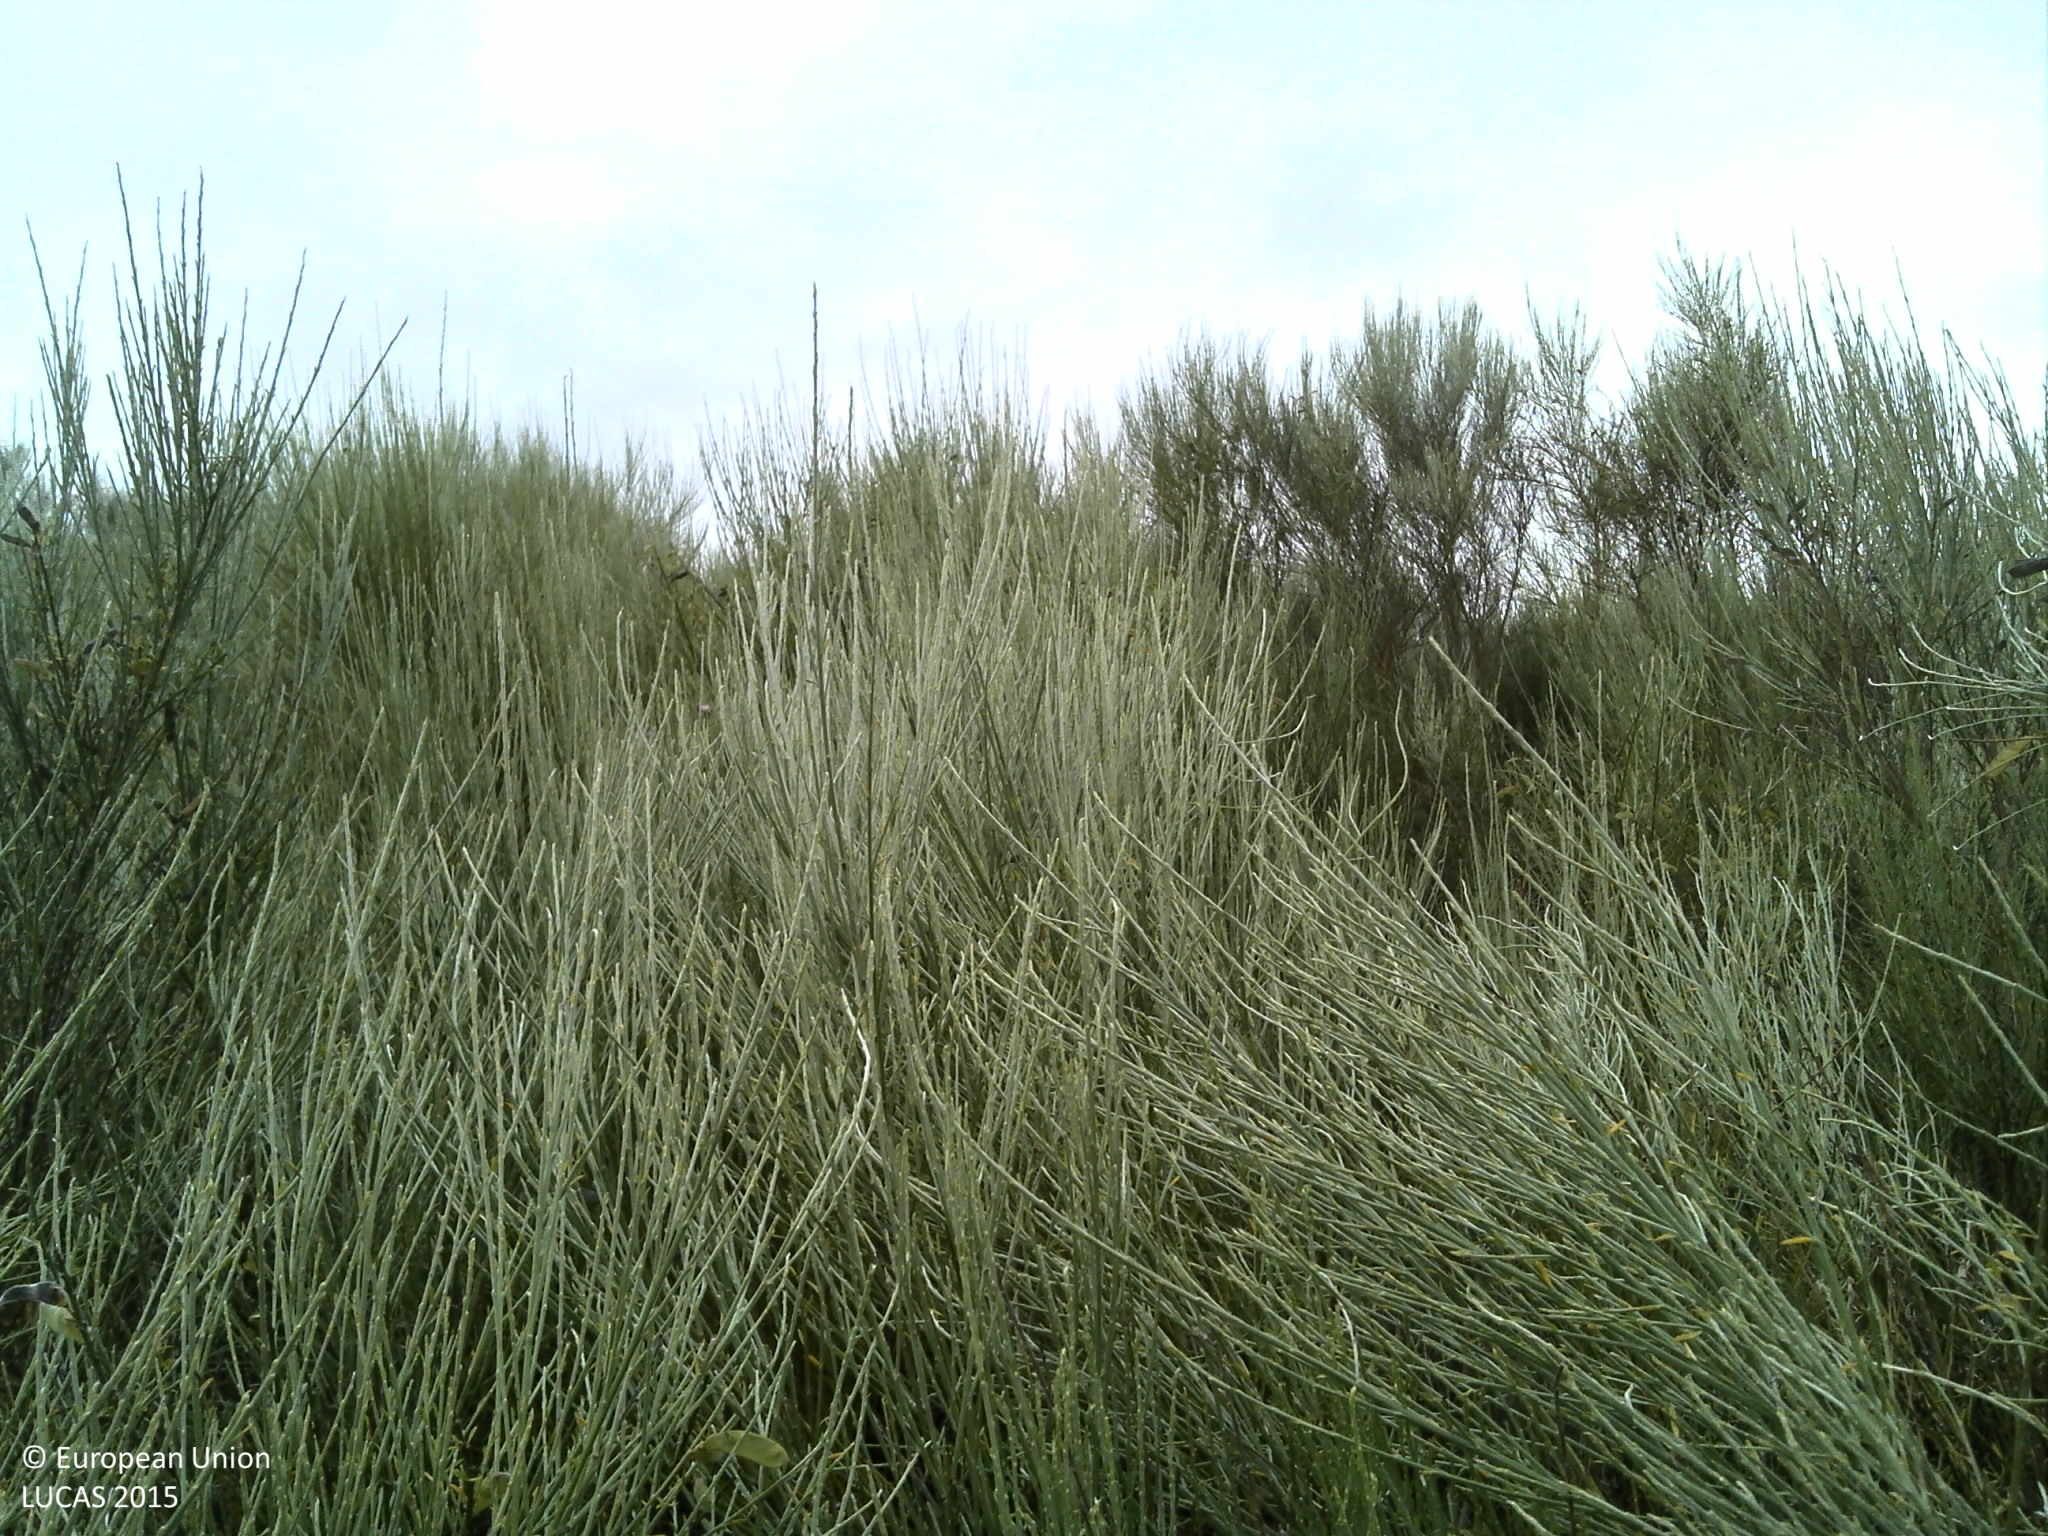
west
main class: Shrubland
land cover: Shrubland without tree cover
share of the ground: > 75 %
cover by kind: shrubs 100 %
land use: Semi-natural and natural areas not in use
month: June
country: PT
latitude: 41.3206
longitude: -6.9676
